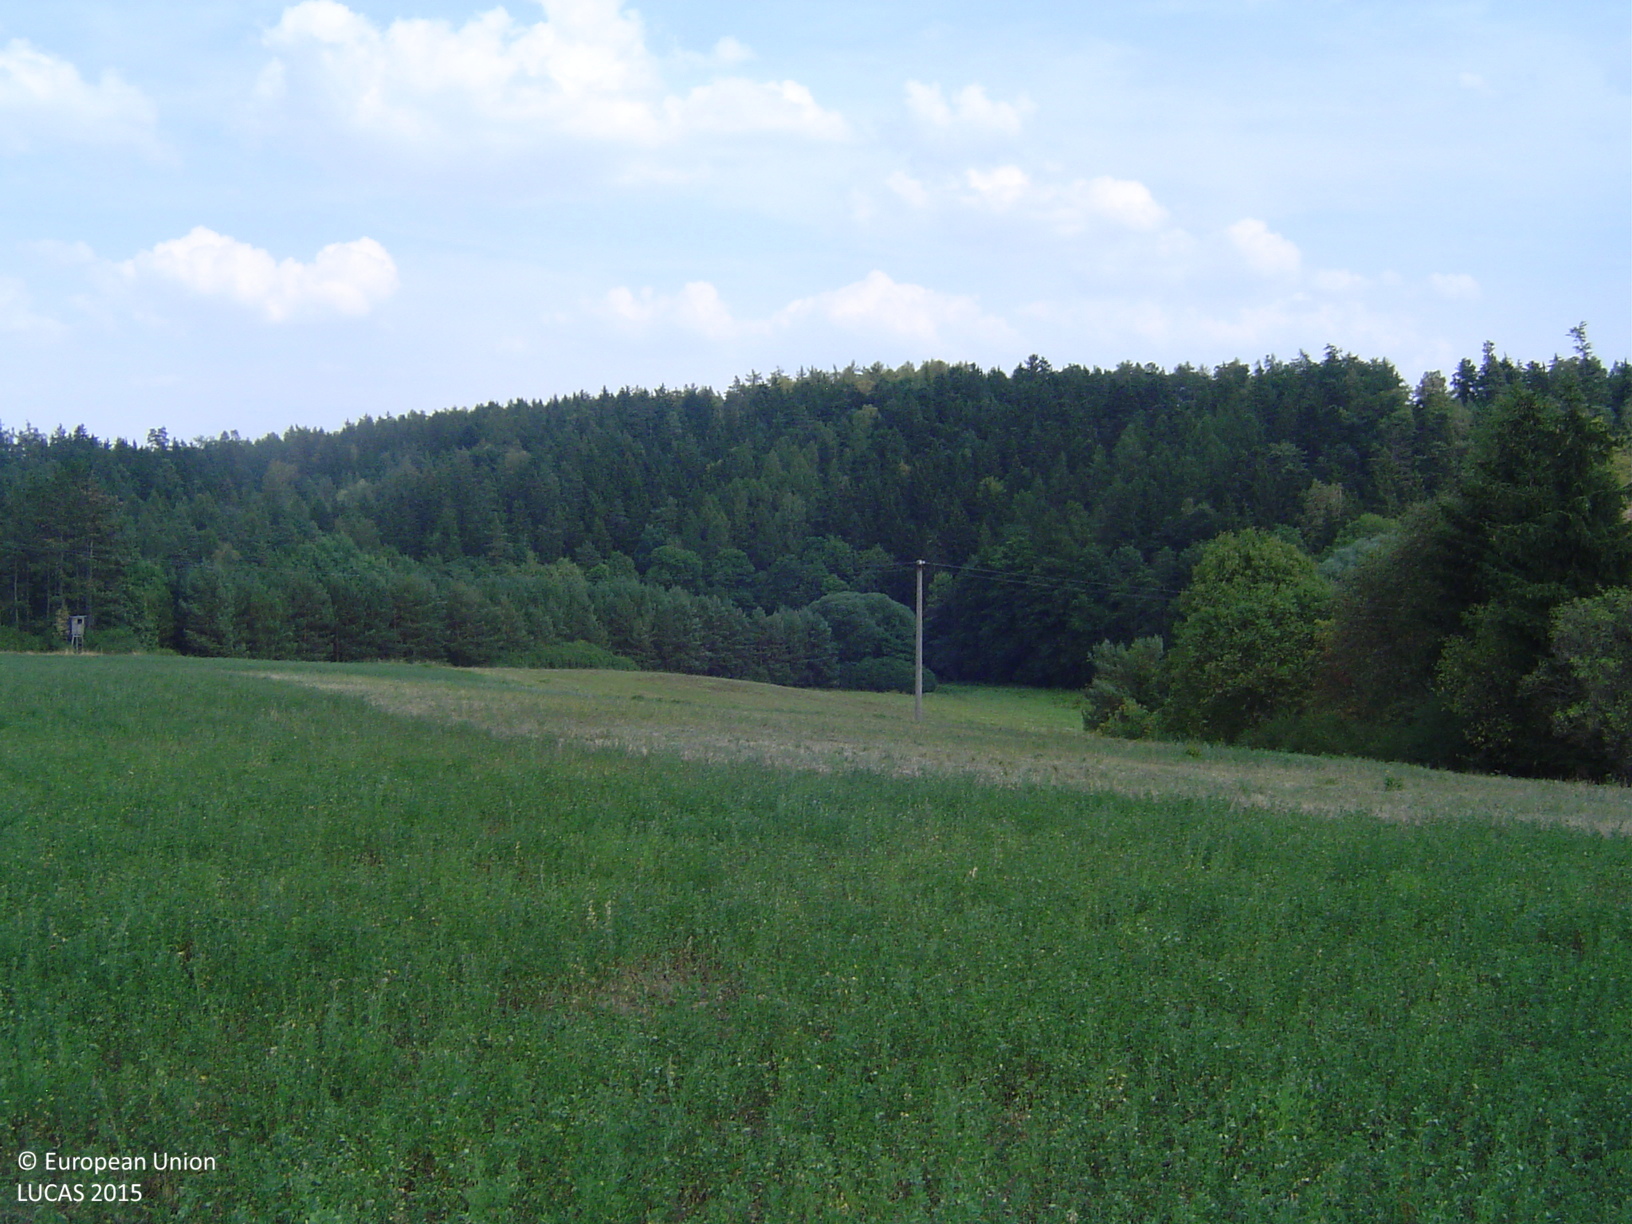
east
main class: Cropland
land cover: Lucerne
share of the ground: > 75 %
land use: Agriculture (excluding fallow land and kitchen gardens)
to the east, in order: Lucerne; Grassland without tree/shrub cover; Electric lines; Grassland without tree/shrub cover
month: August
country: CZ
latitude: 50.0947
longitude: 14.0408
